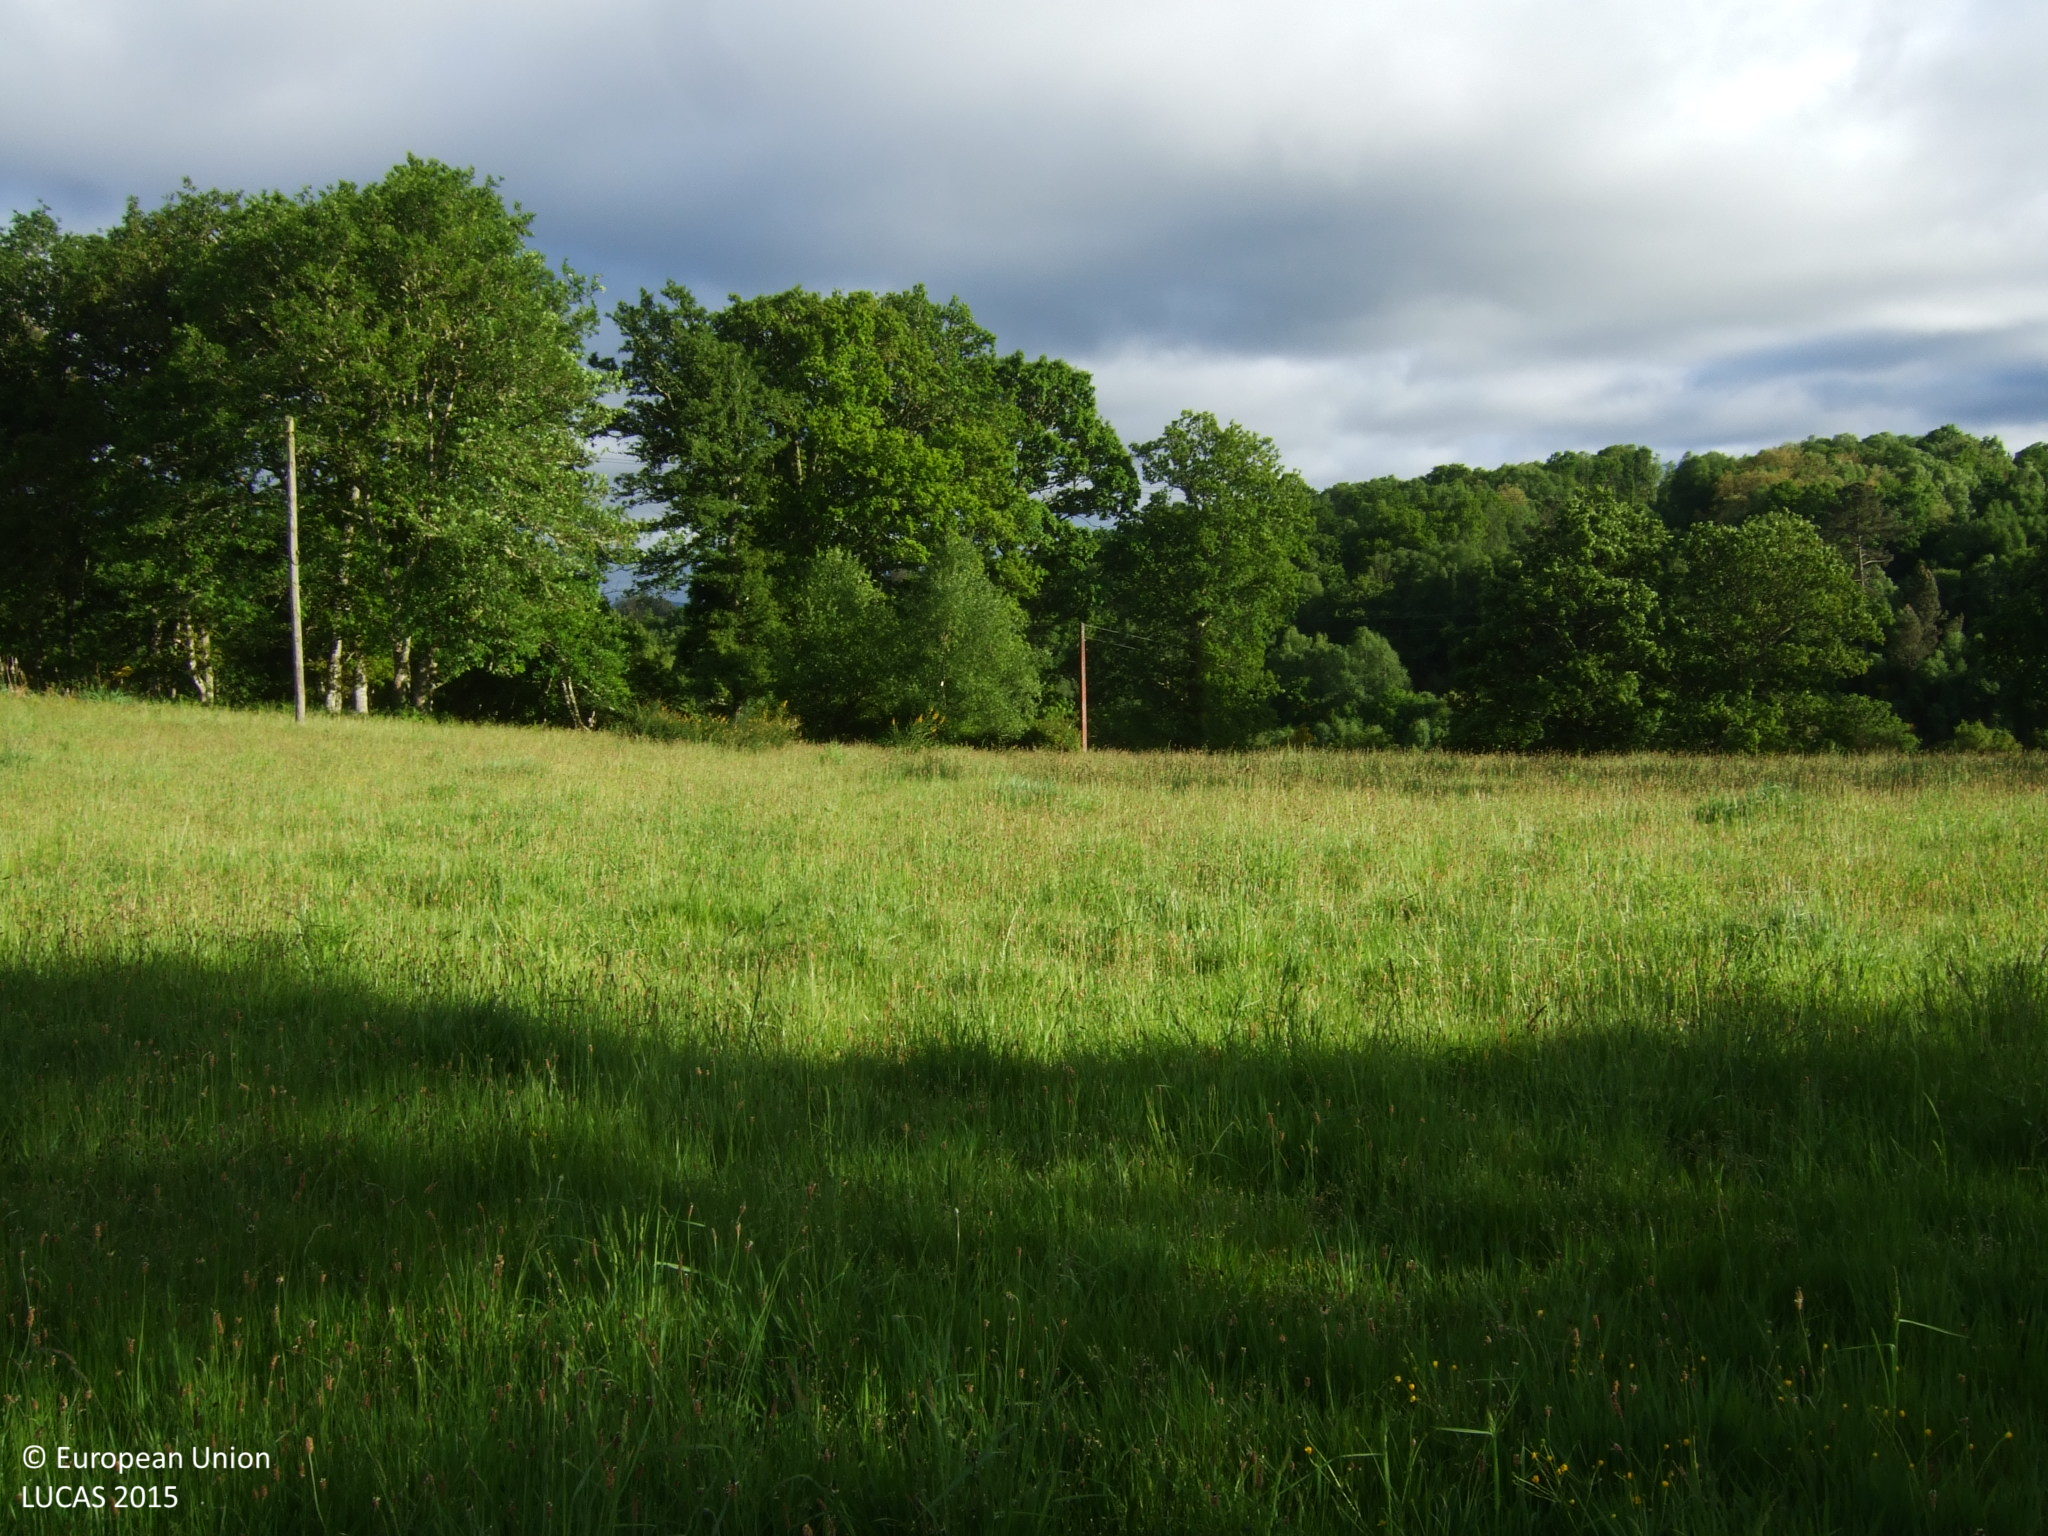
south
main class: Grassland
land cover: Grassland without tree/shrub cover
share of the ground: > 75 %
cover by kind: herbaceous plants 100 %
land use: Agriculture (excluding fallow land and kitchen gardens)
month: May
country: ES
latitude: 43.2852
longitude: -7.7461
